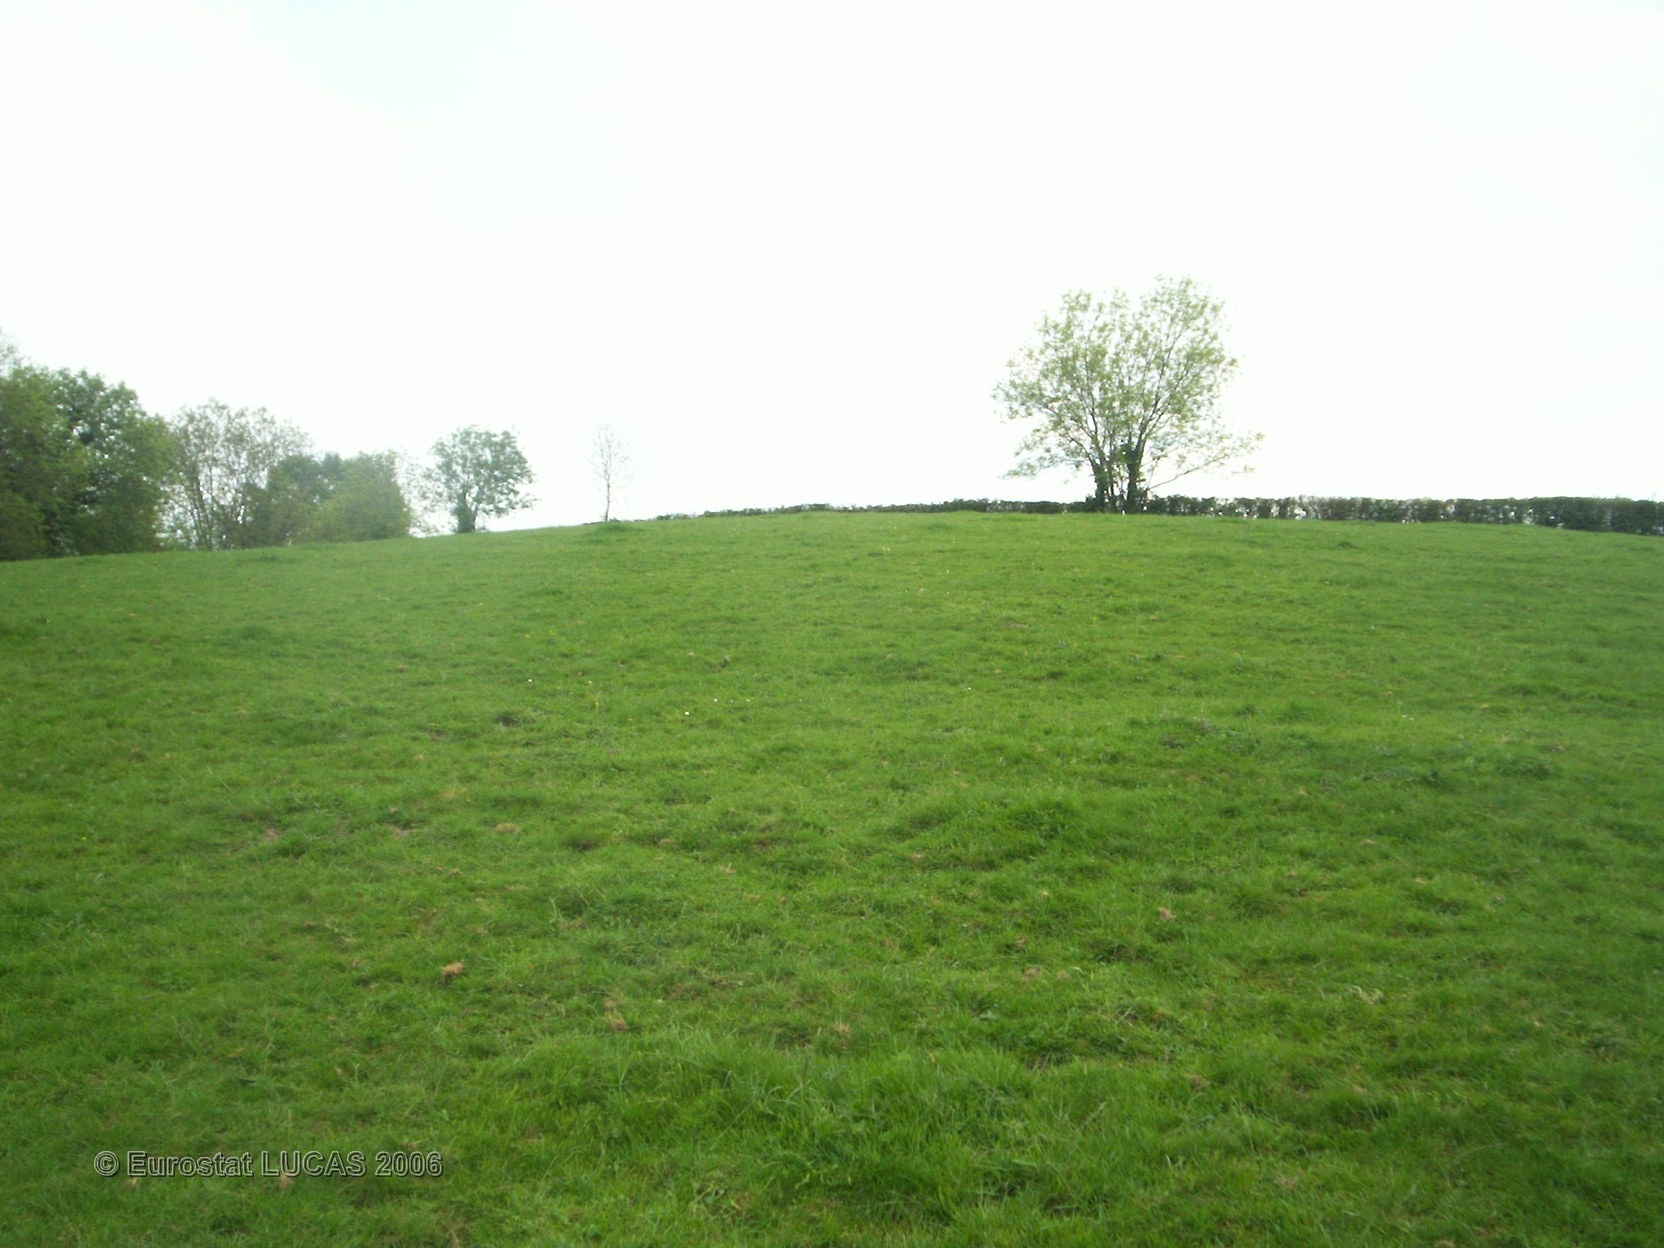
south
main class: Grassland
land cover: Grassland without tree/shrub cover
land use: Agriculture (excluding fallow land and kitchen gardens)
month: May
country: FR
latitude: 46.4901
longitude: 3.1058
